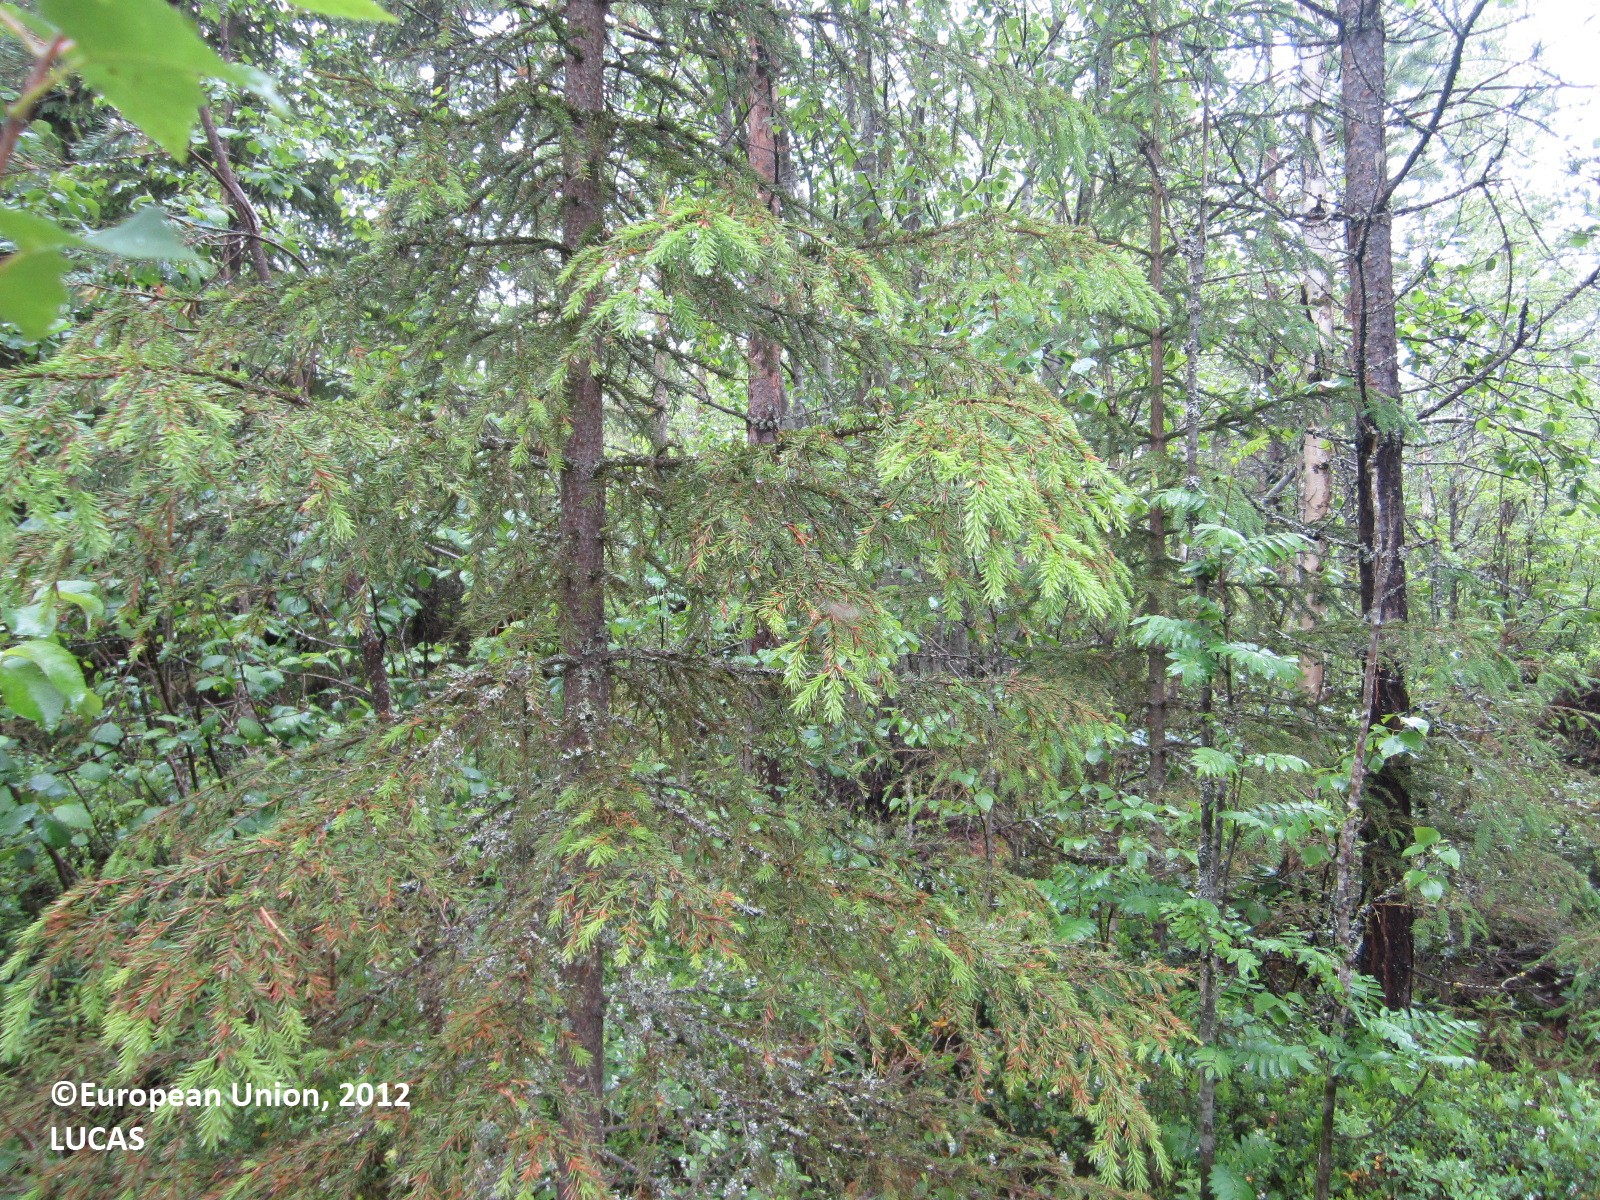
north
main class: Woodland
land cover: Pine dominated mixed woodland
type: boreal forest
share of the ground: > 75 %
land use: Forestry
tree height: > 5 m
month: June
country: FI
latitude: 64.5961
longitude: 29.3211
